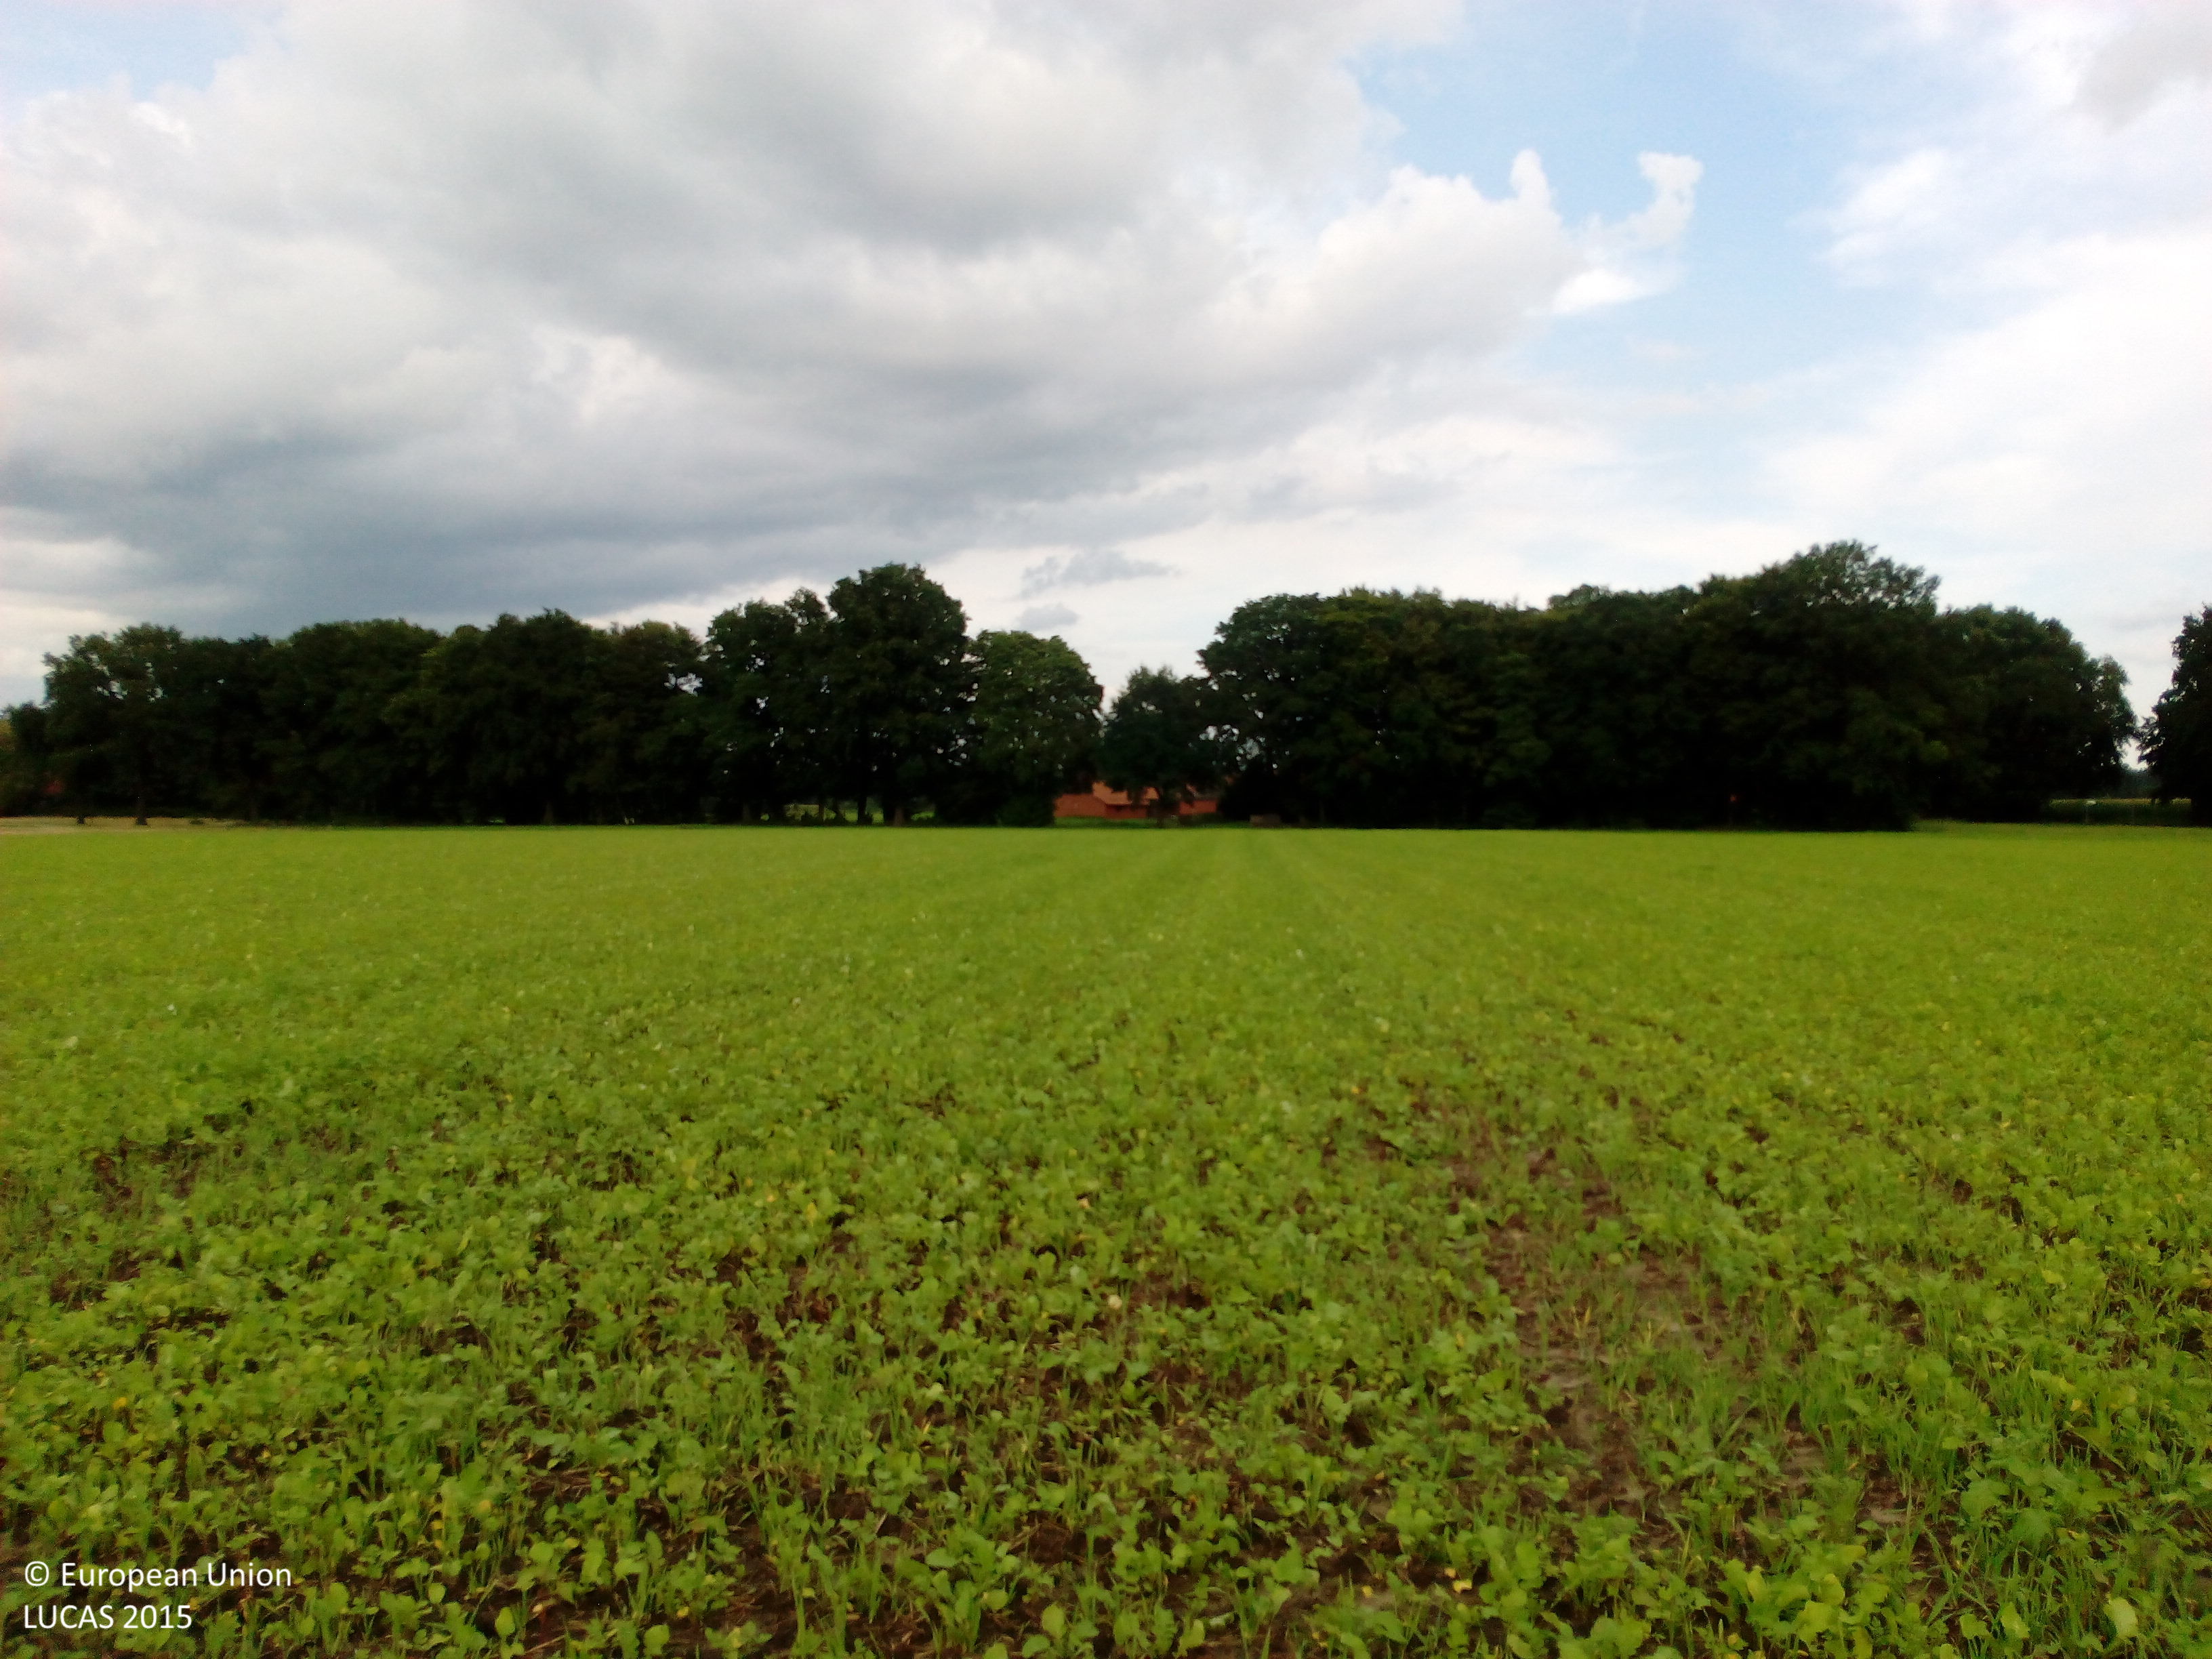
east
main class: Grassland
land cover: Spontaneously vegetated surfaces
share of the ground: > 75 %
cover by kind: herbaceous plants 100 %
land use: Agriculture (excluding fallow land and kitchen gardens)
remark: Harvested field
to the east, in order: Spontaneously vegetated surfaces; Grass margins; Rivers and streams; Broadleaved woodland; Artificial constructions in urban areas
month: August
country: DE
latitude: 52.4328
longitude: 8.0149
